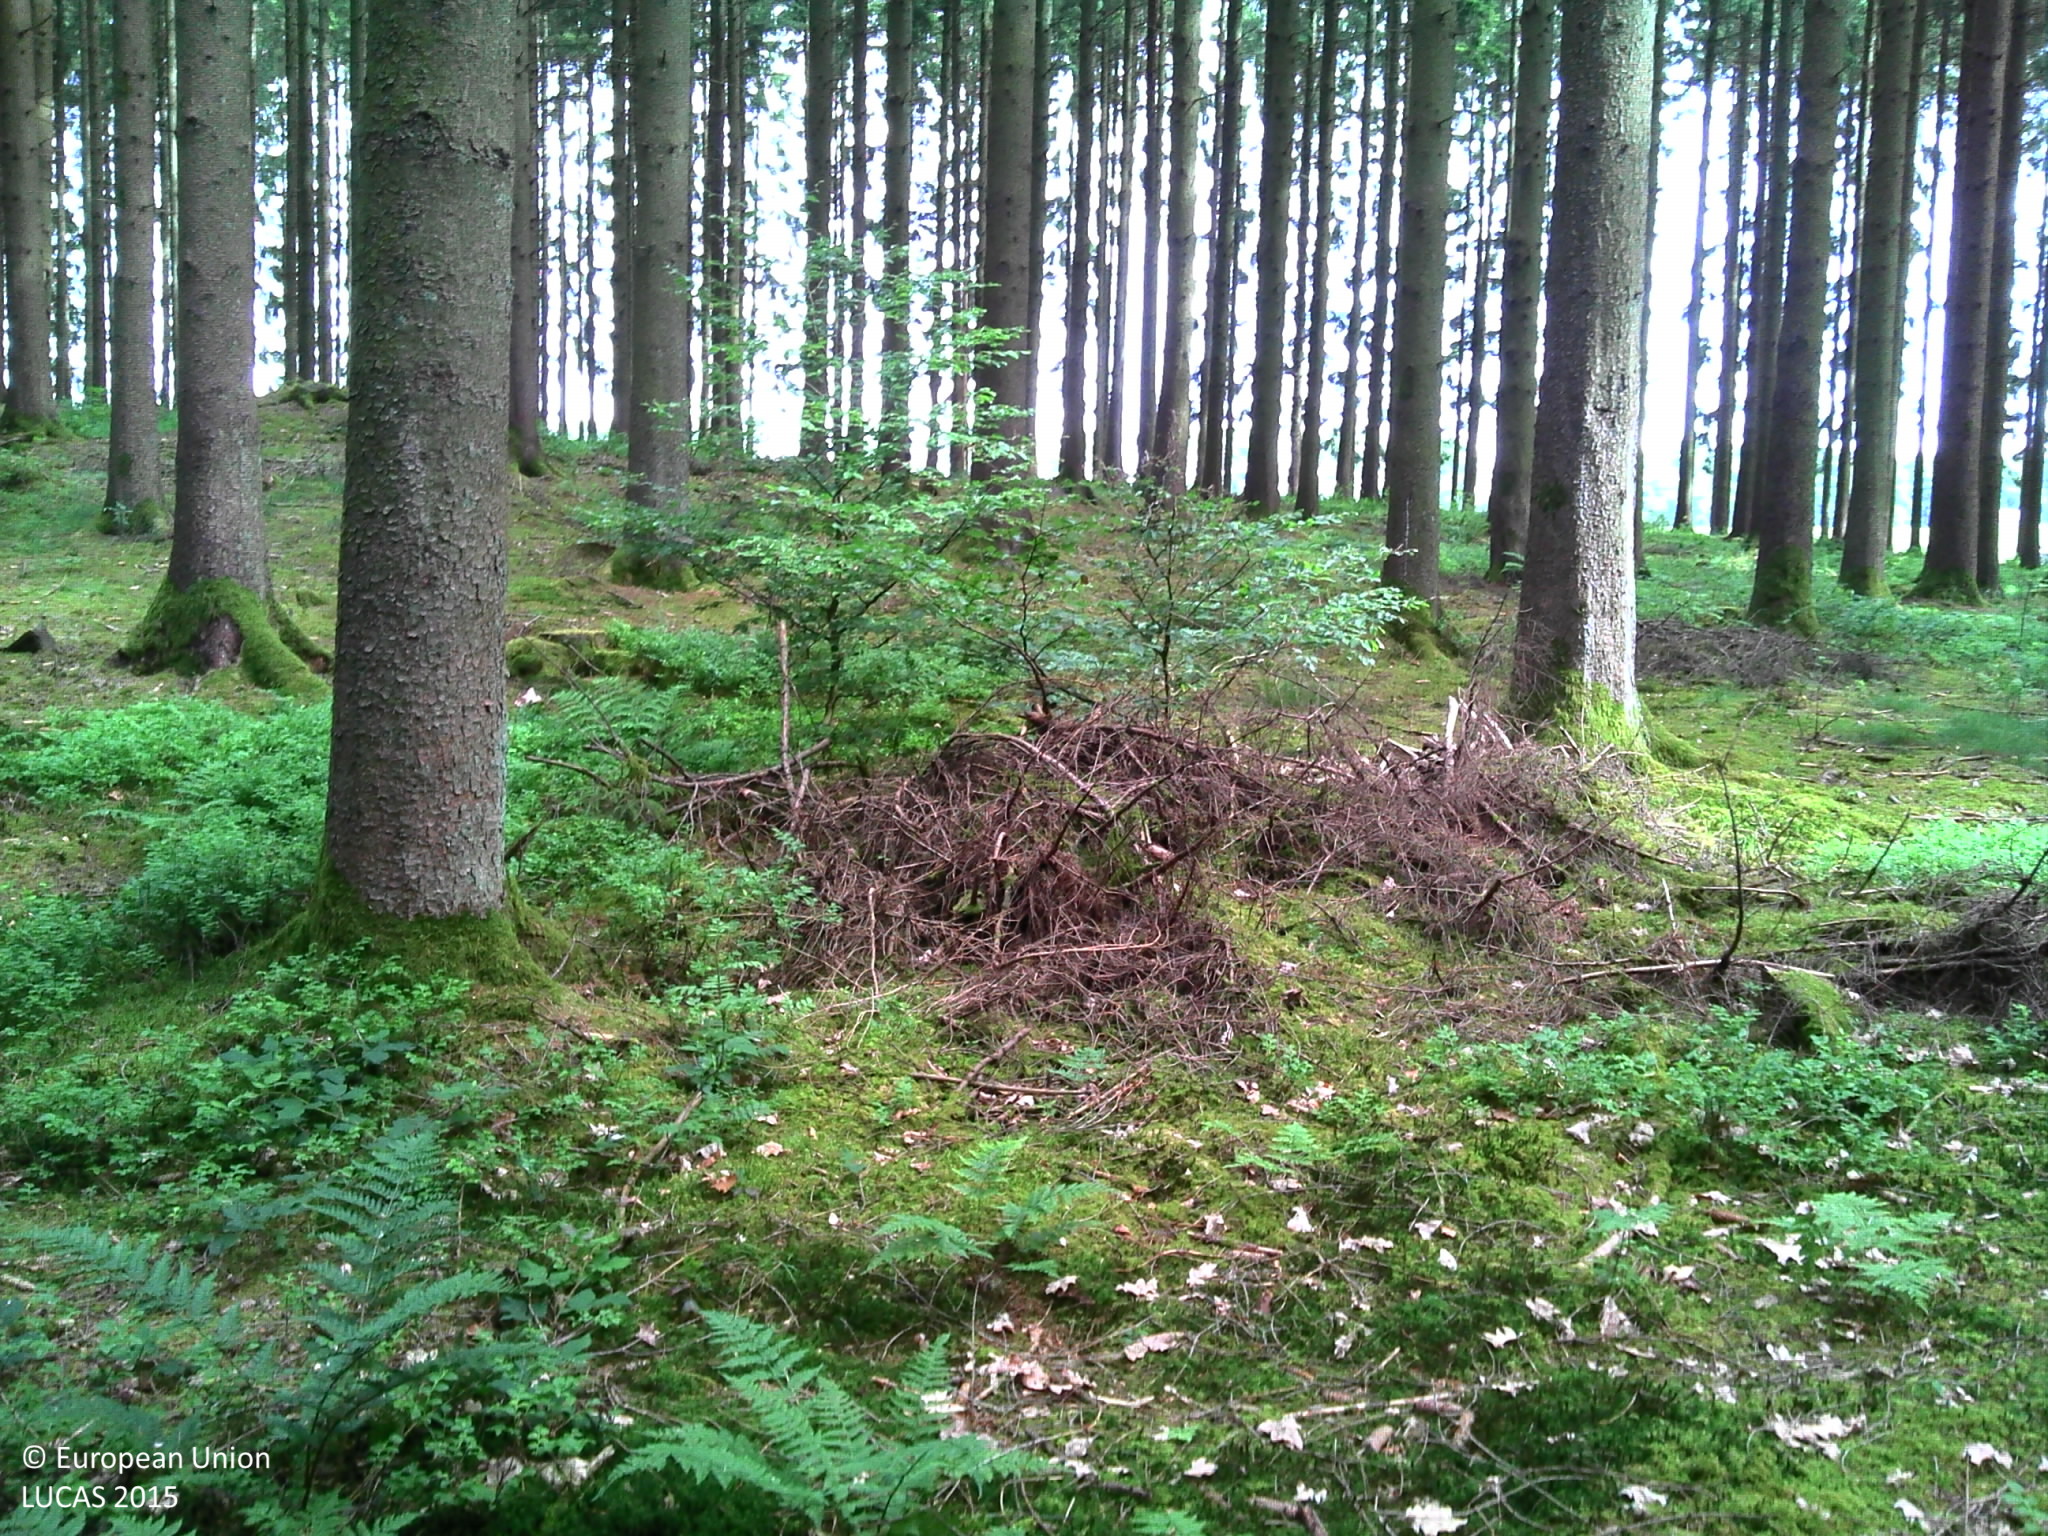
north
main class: Woodland
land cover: Spruce dominated coniferous woodland
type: alpine coniferous forest
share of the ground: > 75 %
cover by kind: coniferous forest trees 80 %, herbaceous plants 10 %, lichens and mosses 10 %
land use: Forestry
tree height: > 5 m
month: June
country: BE
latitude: 49.9254
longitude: 5.3037
